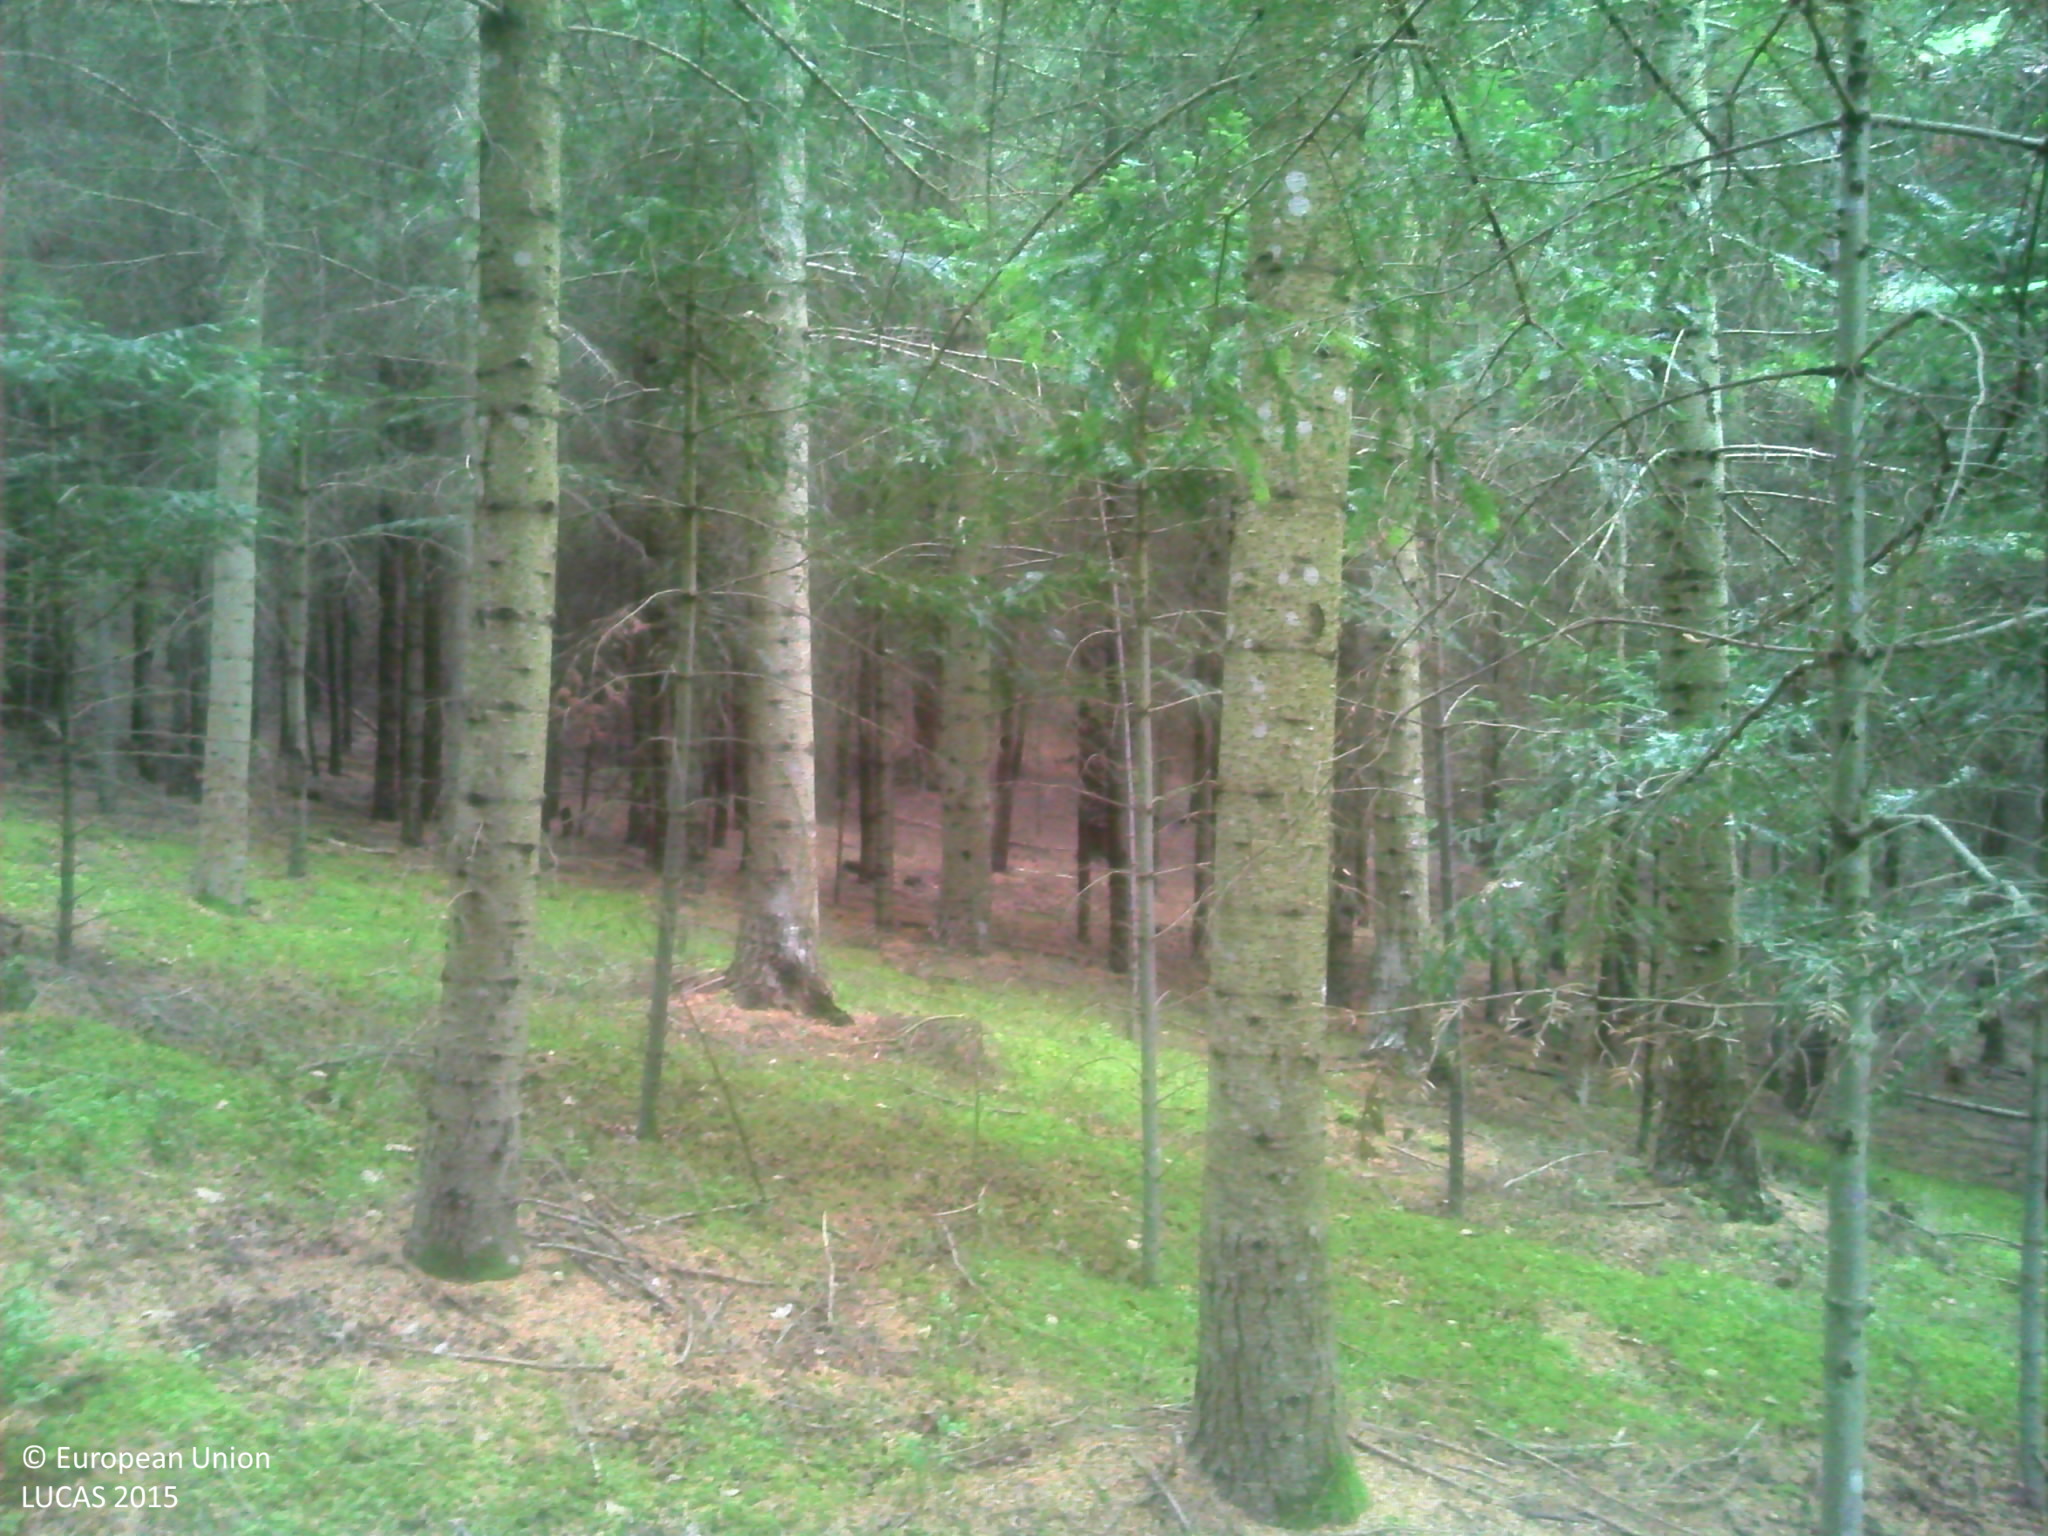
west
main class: Woodland
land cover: Spruce dominated coniferous woodland
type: exotic forest
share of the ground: > 75 %
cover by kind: coniferous forest trees 80 %, lichens and mosses 10 %, herbaceous plants 5 %, unconsolidated bare surface 5 %
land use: Forestry
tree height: > 5 m
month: July
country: FR
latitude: 45.1630
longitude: 3.8590
